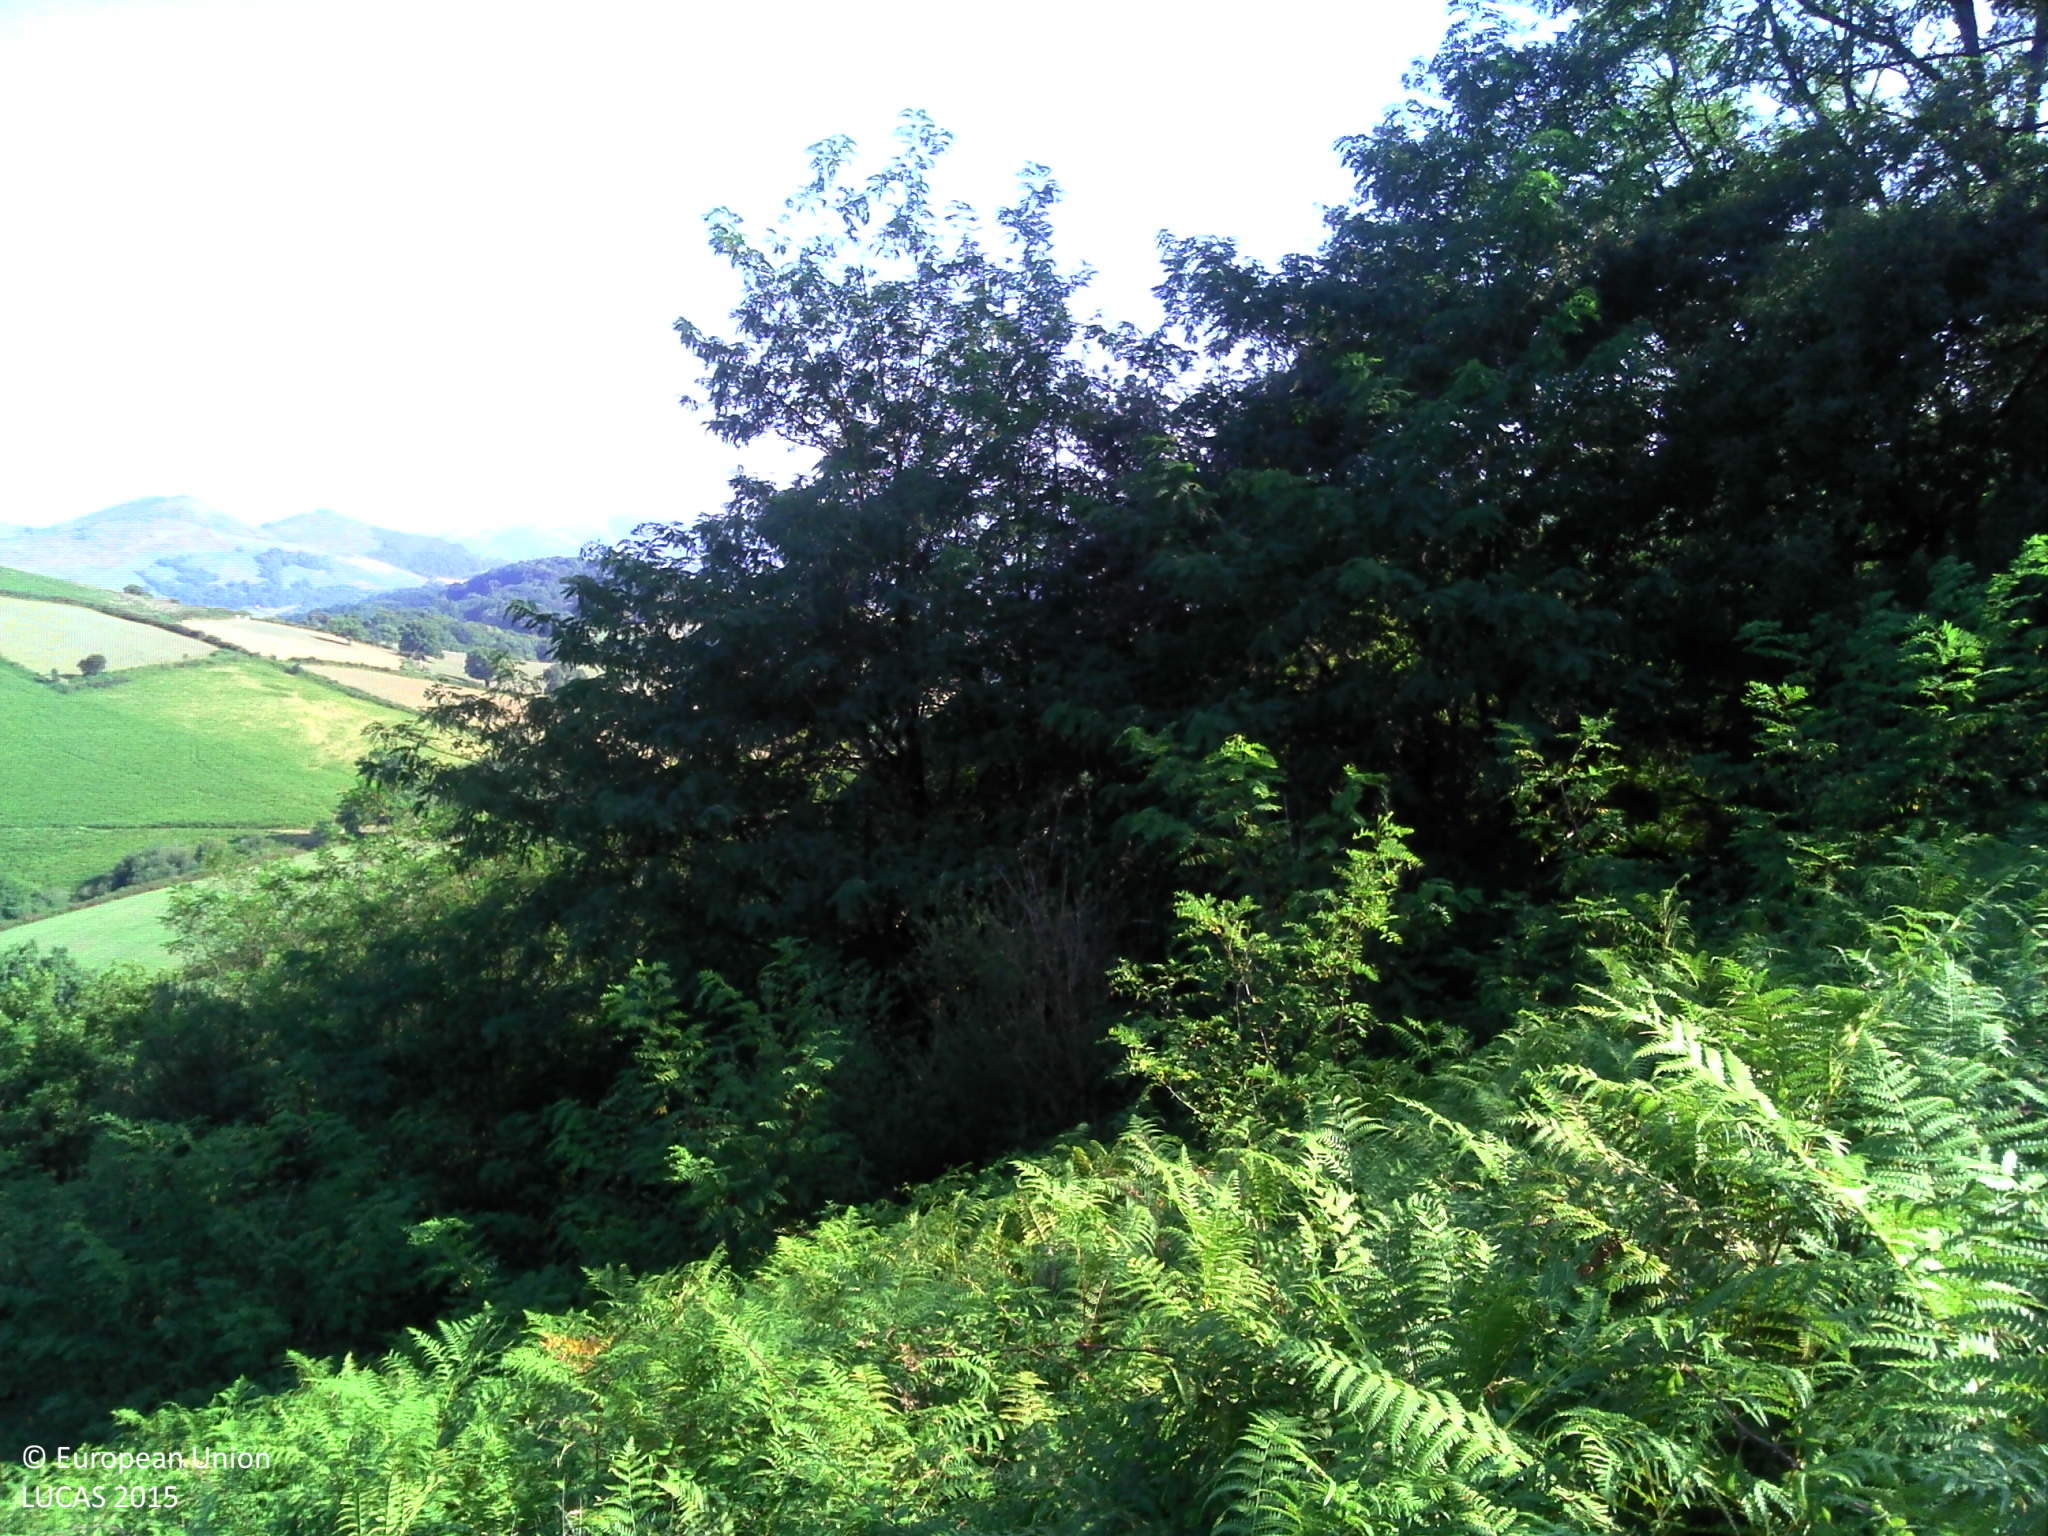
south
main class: Grassland
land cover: Grassland with sparse tree/shrub cover
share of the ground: > 75 %
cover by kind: herbaceous plants 85 %, shrubs 10 %, broadleaved forest trees 5 %
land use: Semi-natural and natural areas not in use
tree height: < 5 m
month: August
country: FR
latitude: 43.3567
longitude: -1.2303
